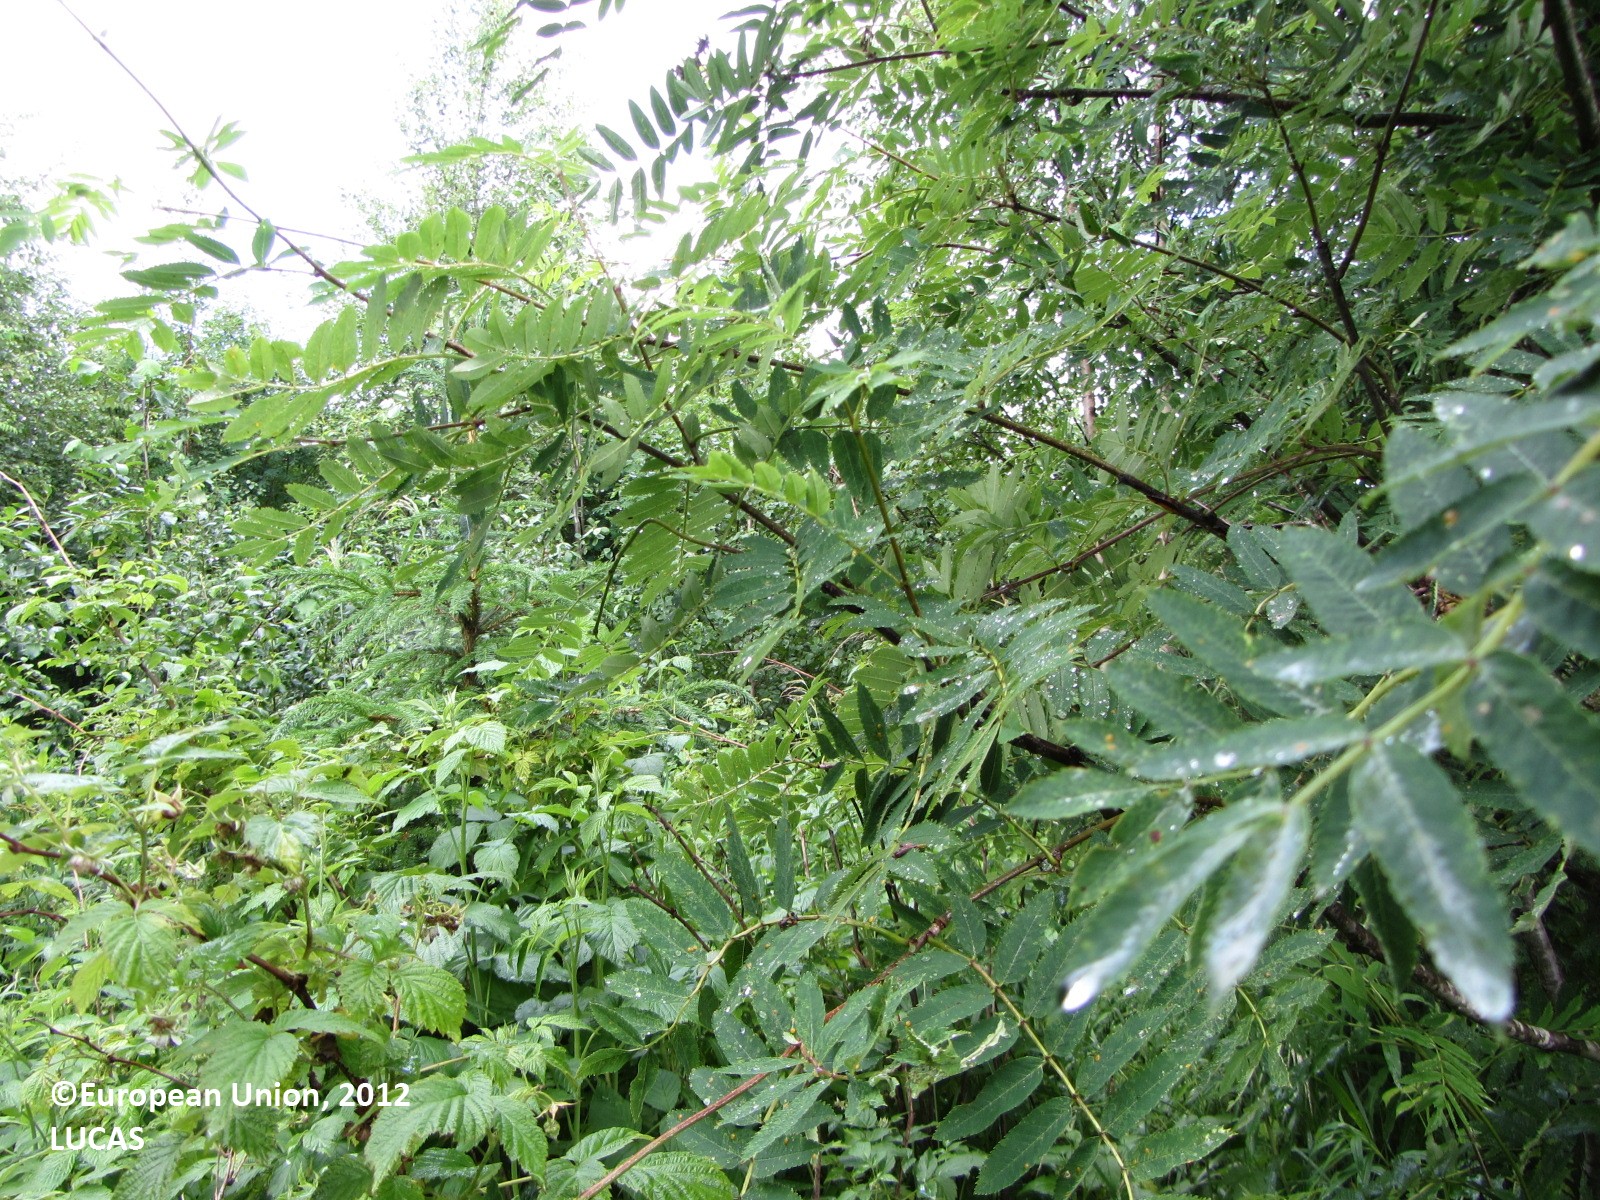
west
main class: Woodland
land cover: Broadleaved woodland
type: boreal forest
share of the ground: 50 - 75 %
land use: Forestry
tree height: > 5 m
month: July
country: FI
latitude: 63.8092
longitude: 25.5532
